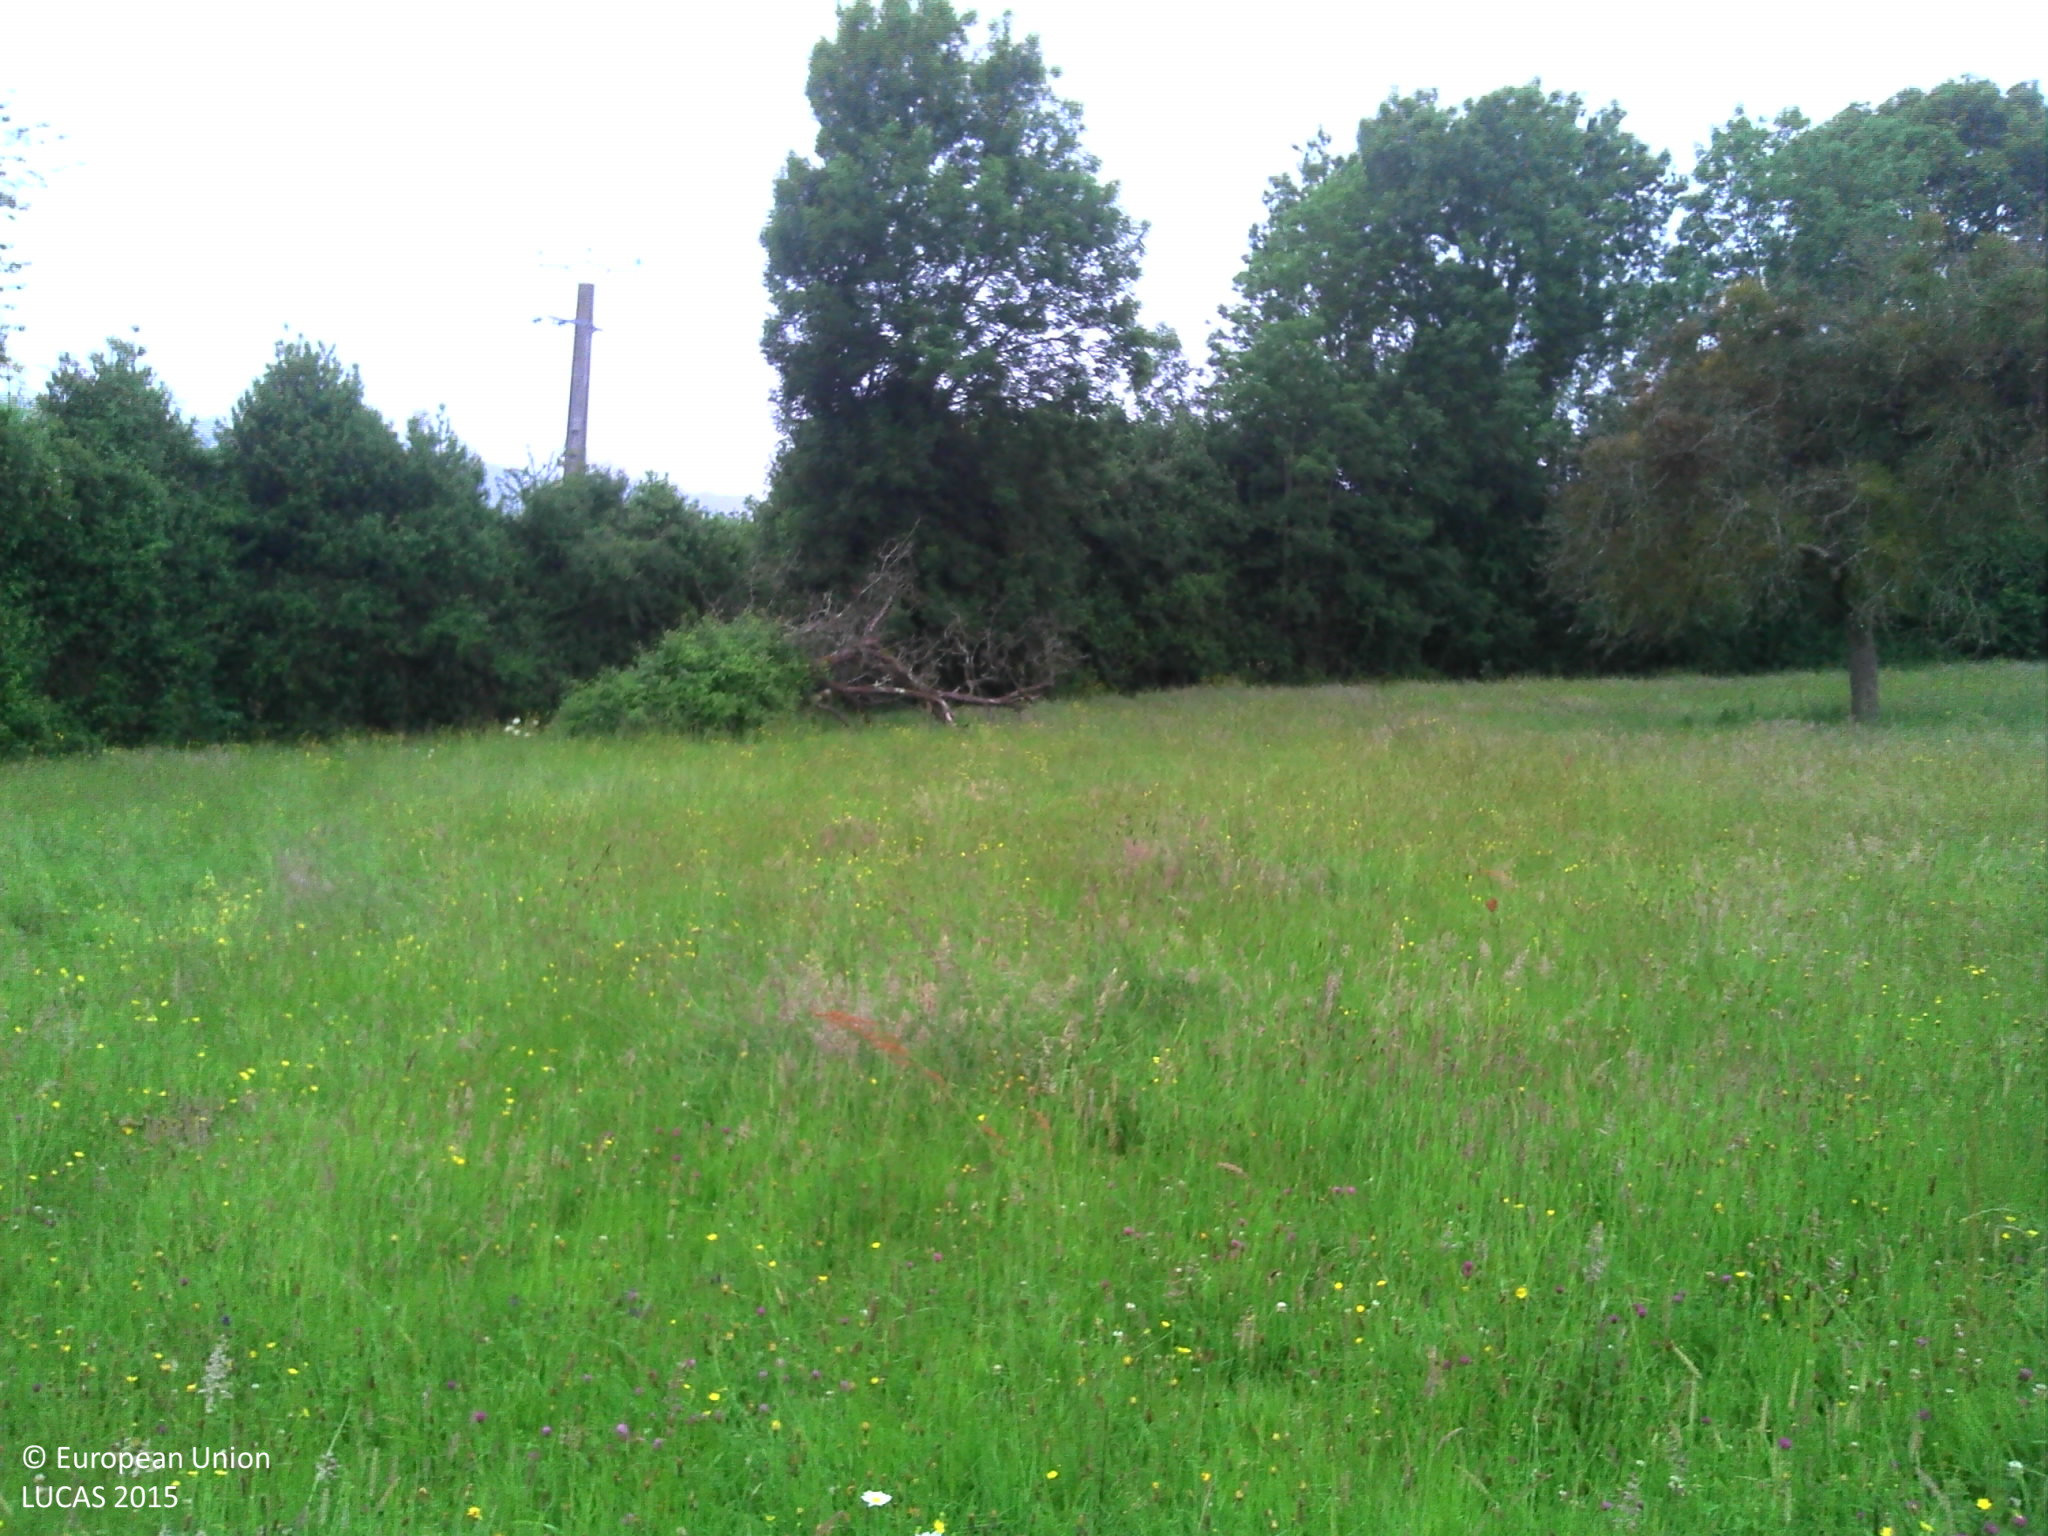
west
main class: Grassland
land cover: Grassland with sparse tree/shrub cover
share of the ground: > 75 %
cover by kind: herbaceous plants 95 %, broadleaved forest trees 5 %
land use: Agriculture (excluding fallow land and kitchen gardens)
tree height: > 5 m
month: June
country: FR
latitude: 49.2395
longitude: 0.0388
